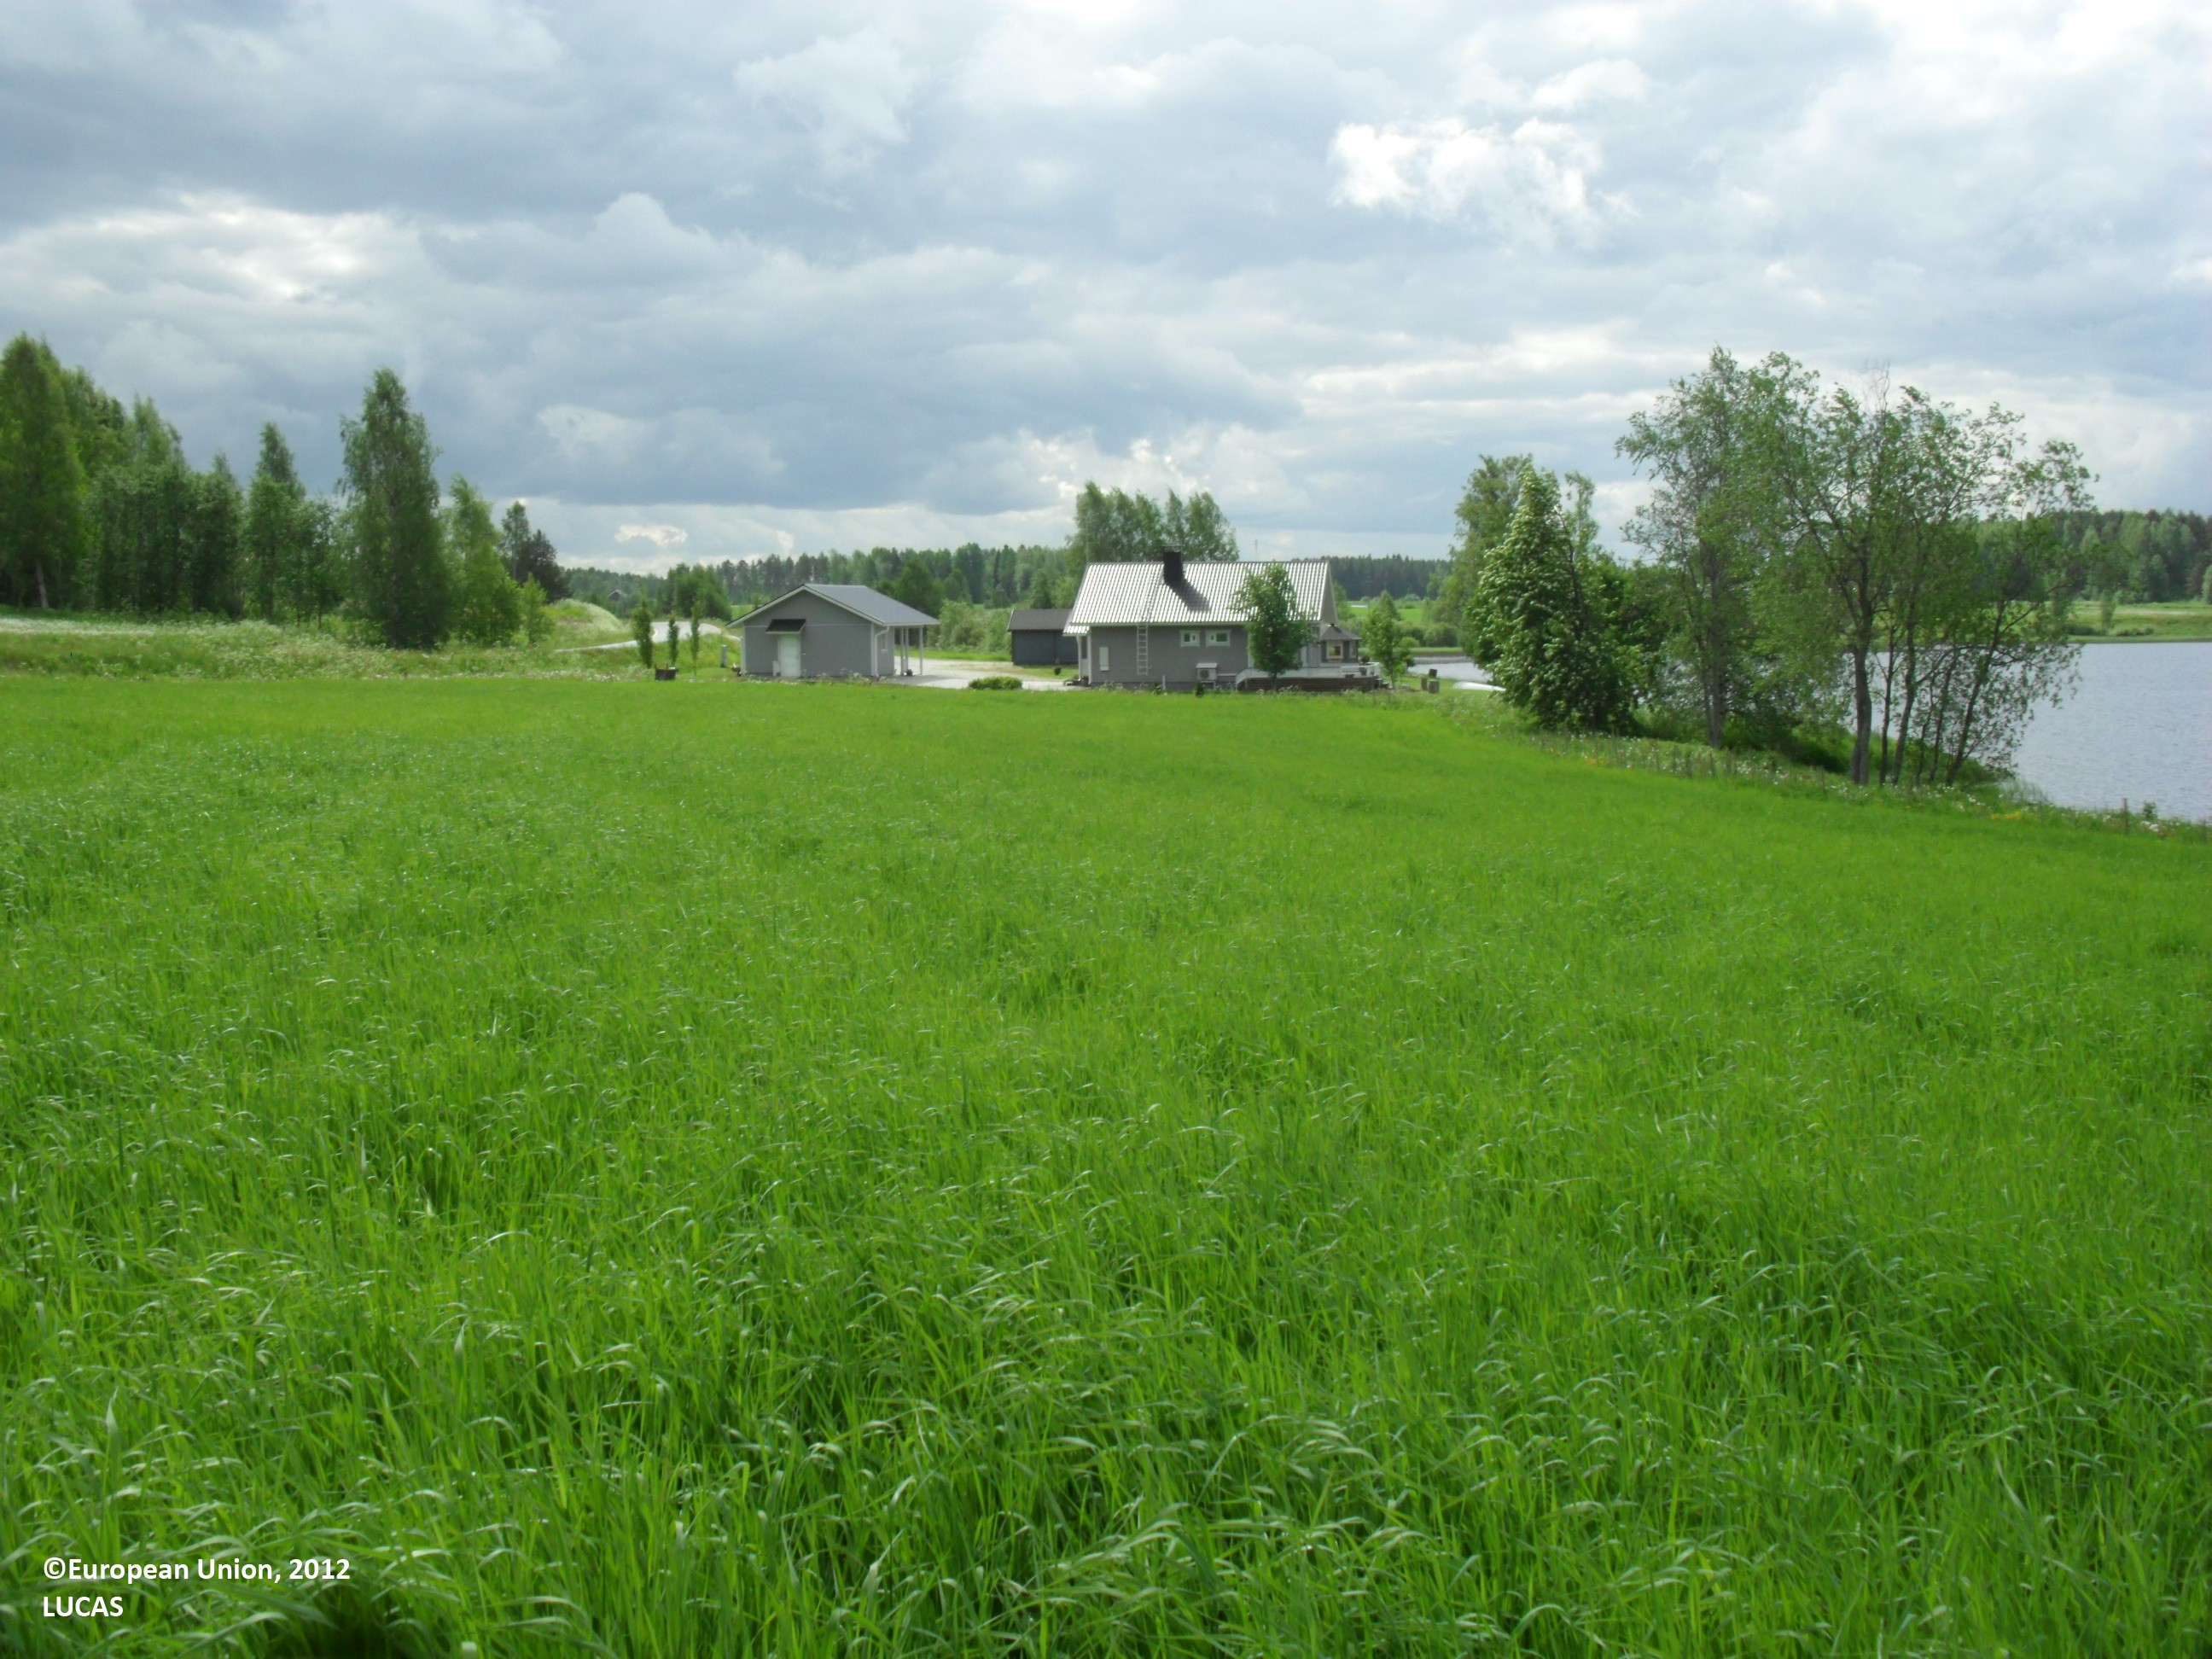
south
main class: Cropland
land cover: Temporary grasslands
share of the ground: > 75 %
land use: Agriculture (excluding fallow land and kitchen gardens)
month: June
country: FI
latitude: 62.7512
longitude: 23.5188
